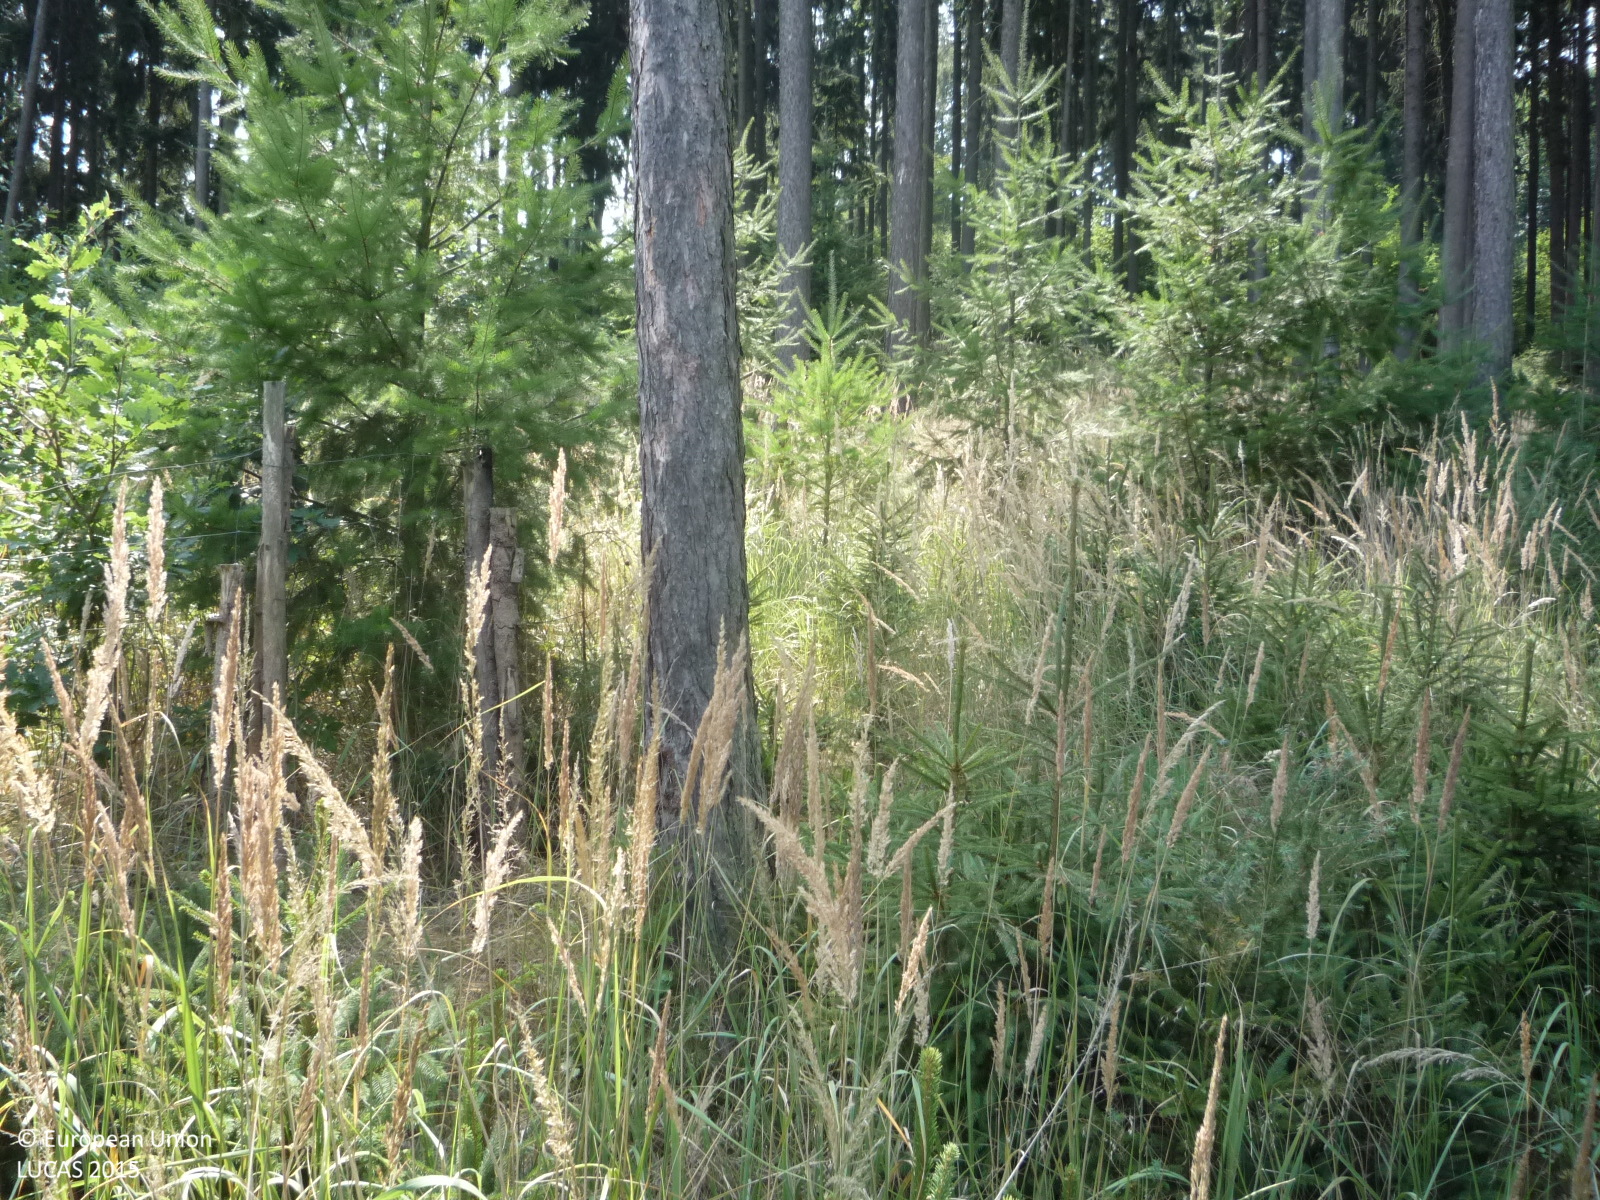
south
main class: Woodland
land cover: Spruce dominated coniferous woodland
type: hemiboreal forest and nemoral coniferous forest and mixed broadleaved-coniferous forest
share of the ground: > 75 %
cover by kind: coniferous forest trees 70 %, herbaceous plants 20 %, broadleaved forest trees 10 %
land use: Forestry
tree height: < 5 m
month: August
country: CZ
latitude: 49.8436
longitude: 14.4932
